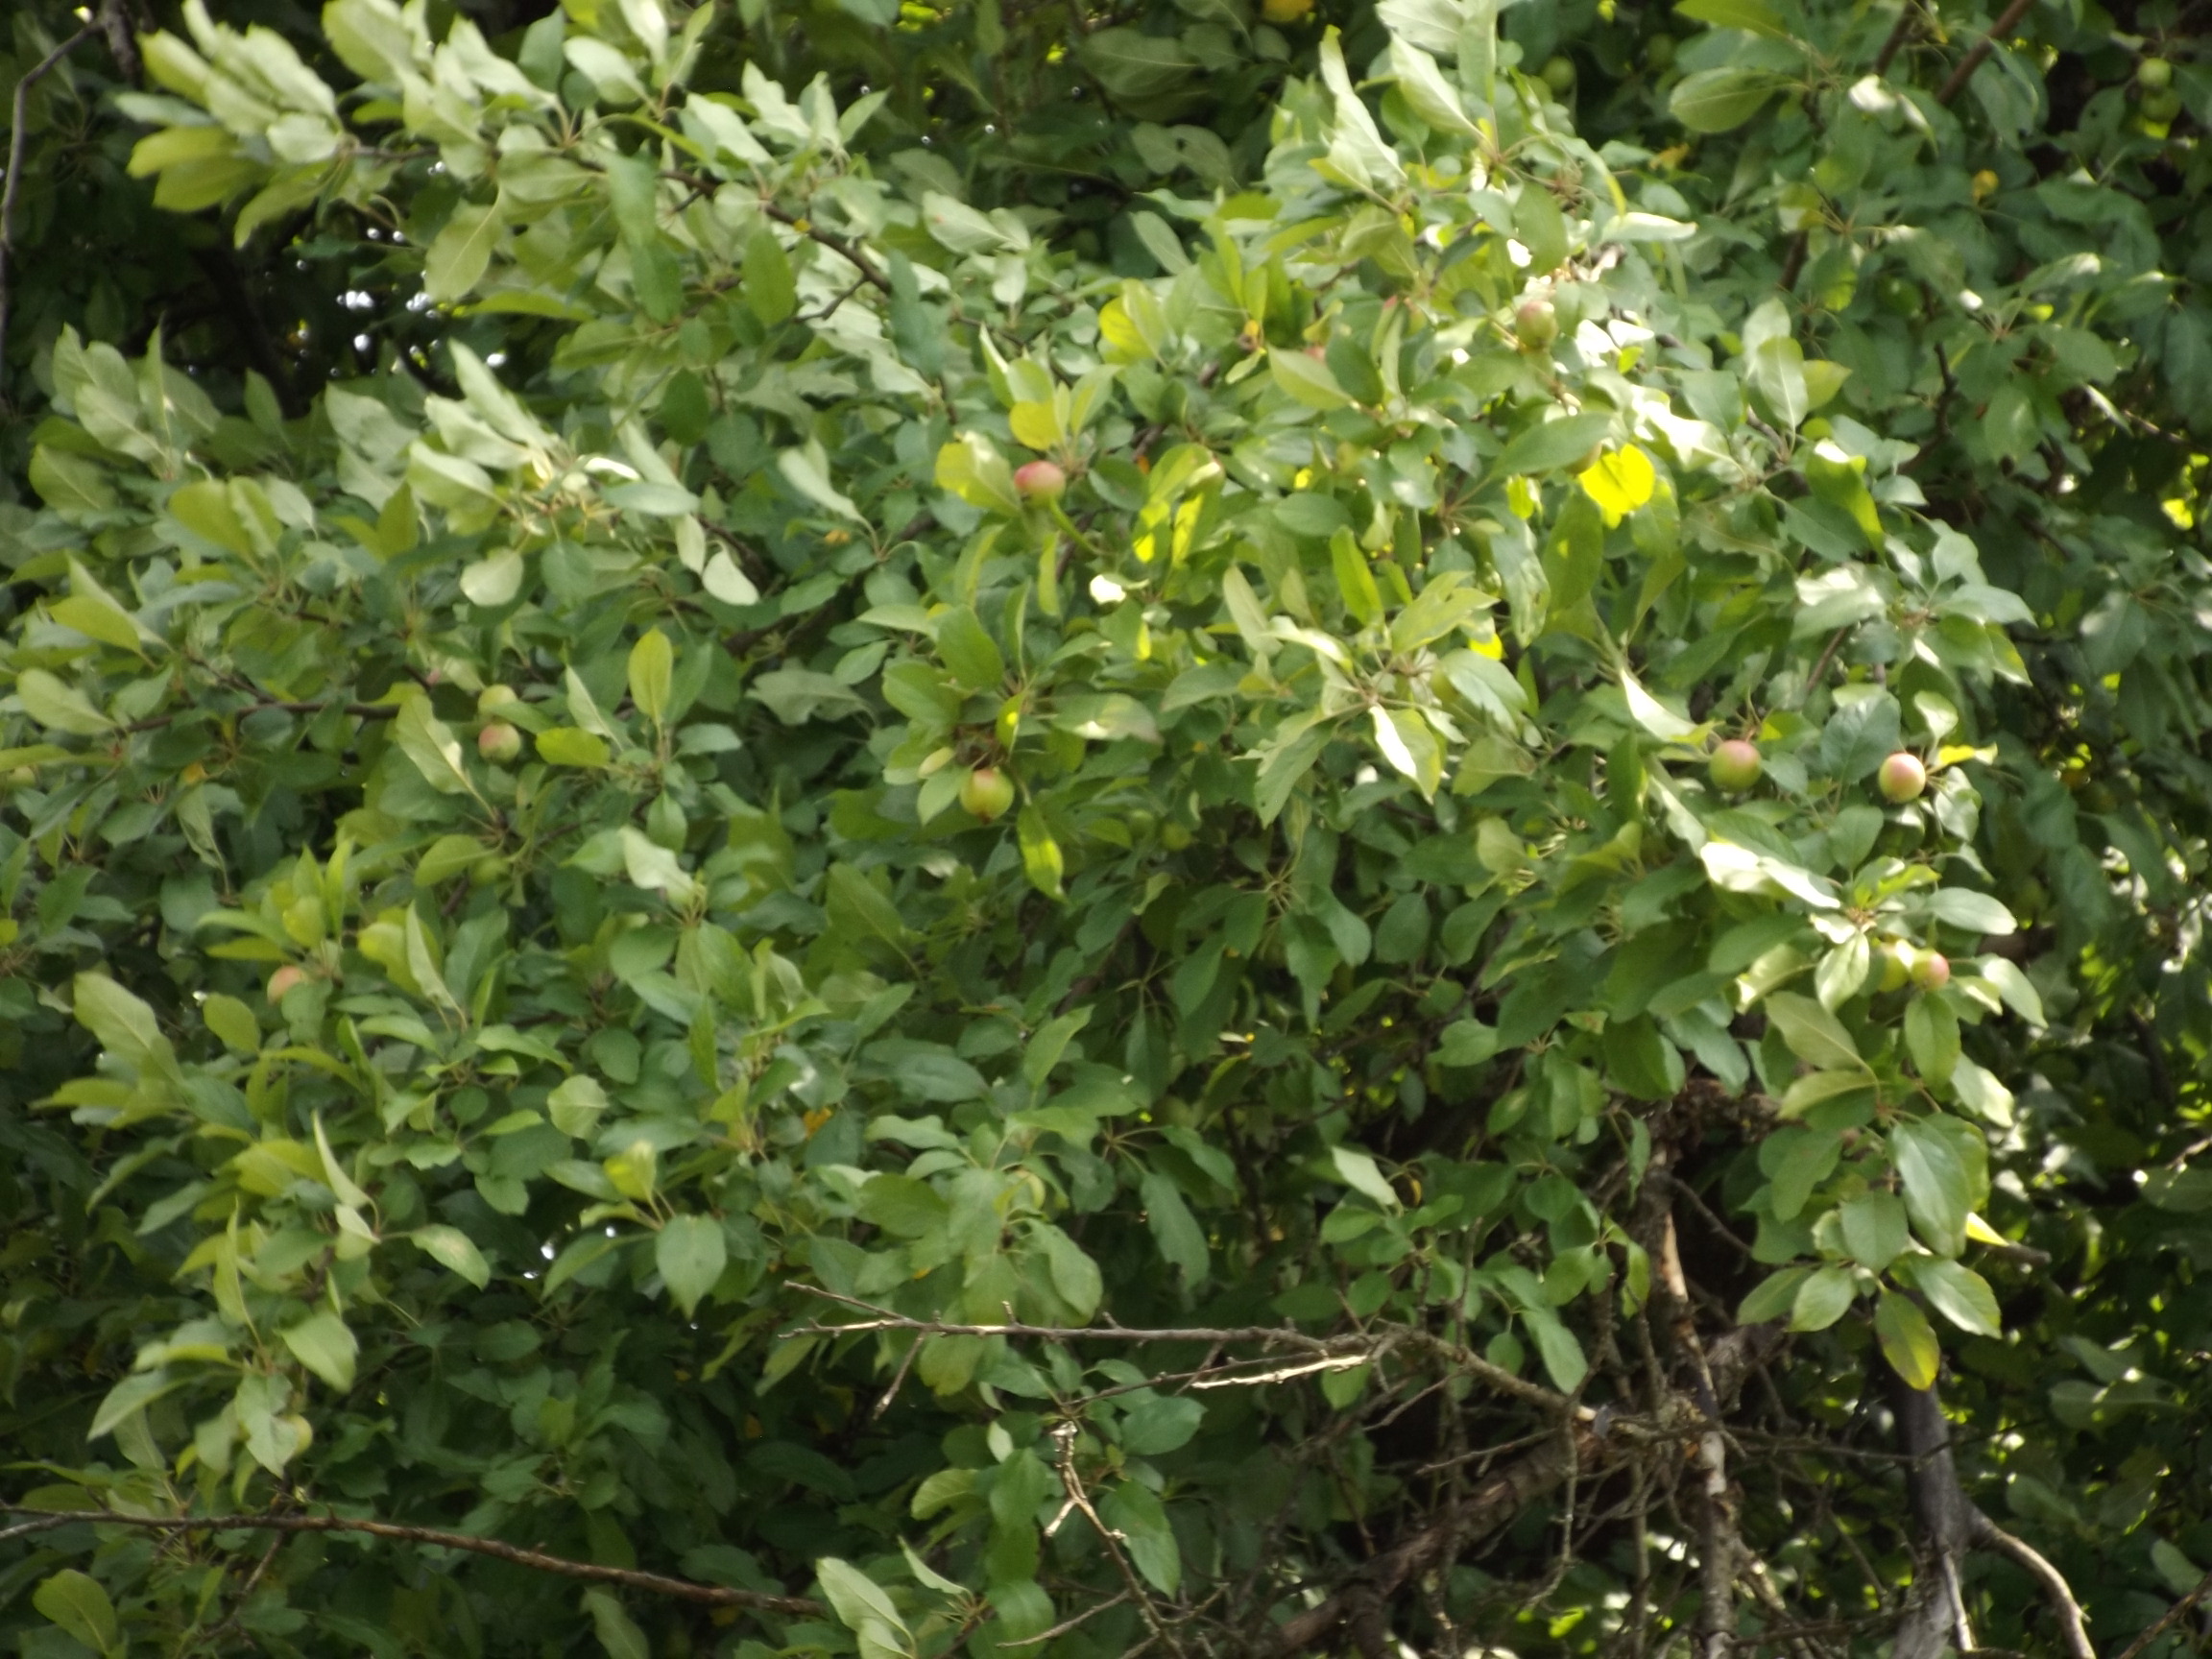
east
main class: Cropland
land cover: Apple fruit
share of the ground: 25 - 50 %
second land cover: Spontaneously vegetated surfaces
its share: > 75 %
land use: Agriculture (excluding fallow land and kitchen gardens)
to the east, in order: Apple fruit; Spontaneously vegetated surfaces; Lucerne; Tracks; Grass margins; Fences; Broadleaved woodland
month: June
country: BG
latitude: 43.5315
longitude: 27.3899
